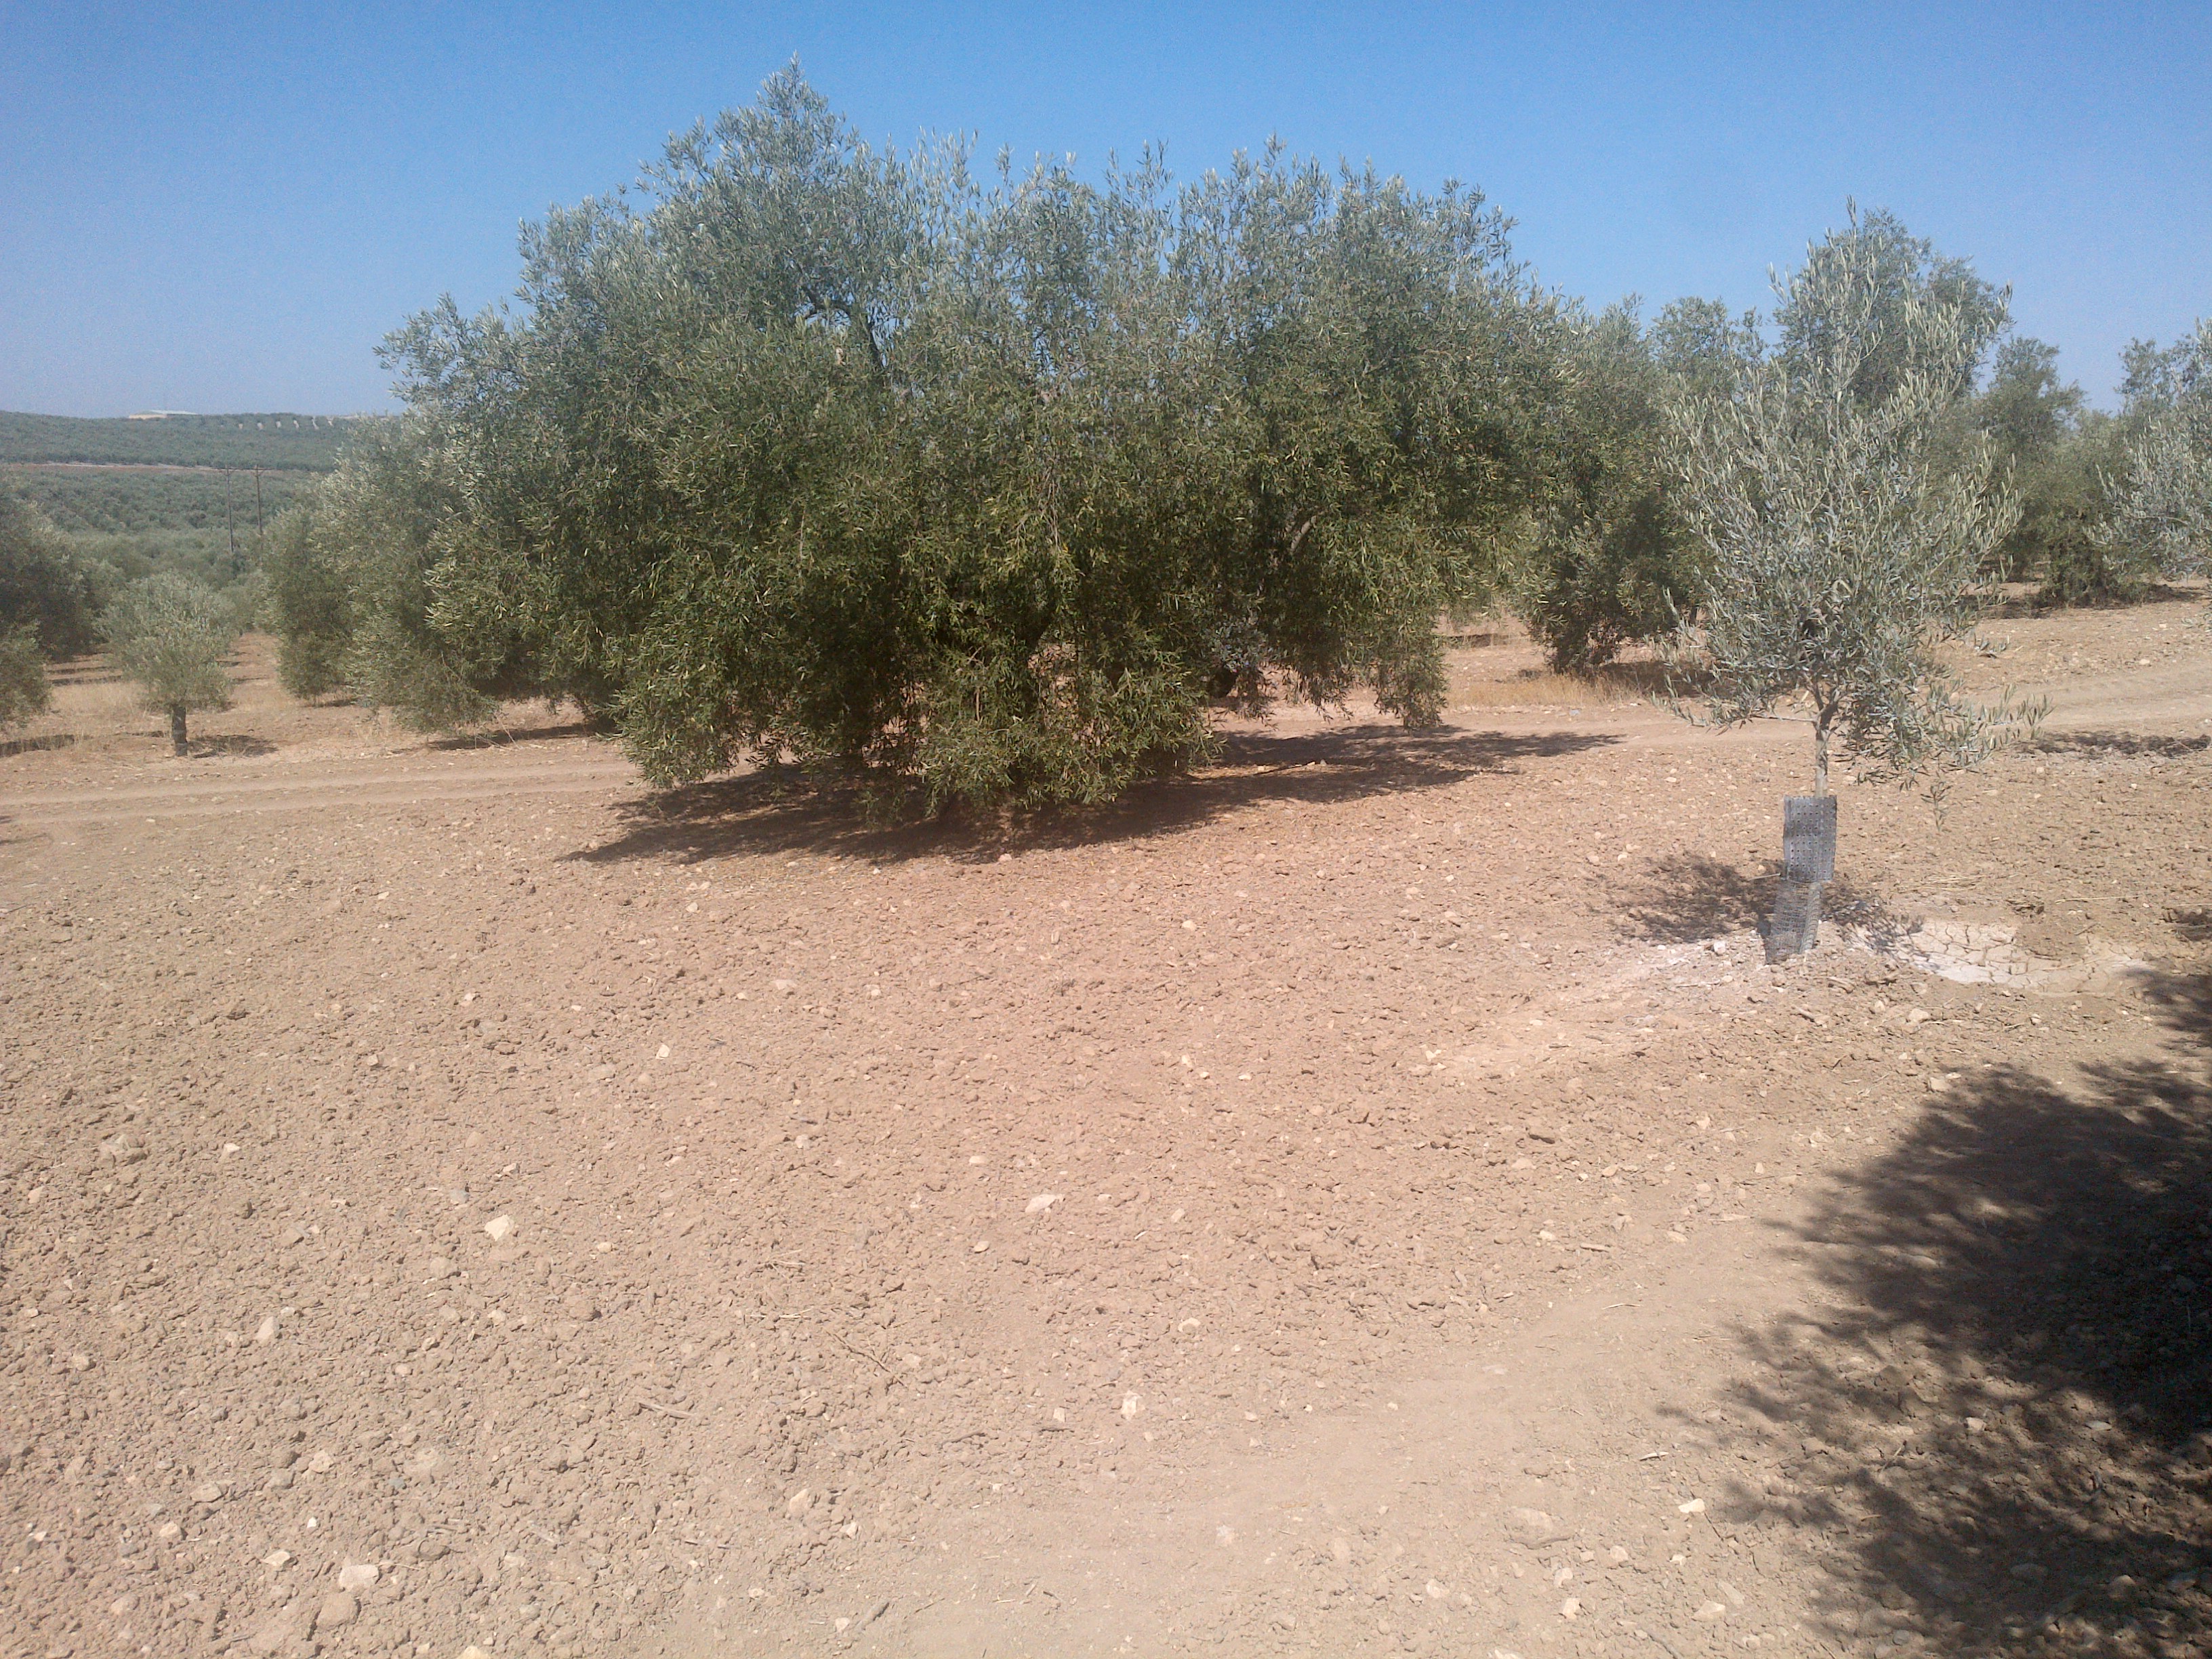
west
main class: Cropland
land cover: Olive groves
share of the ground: 50 - 75 %
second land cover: Other bare soil
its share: > 75 %
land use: Agriculture (excluding fallow land and kitchen gardens)
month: July
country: ES
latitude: 37.4041
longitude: -4.8400
